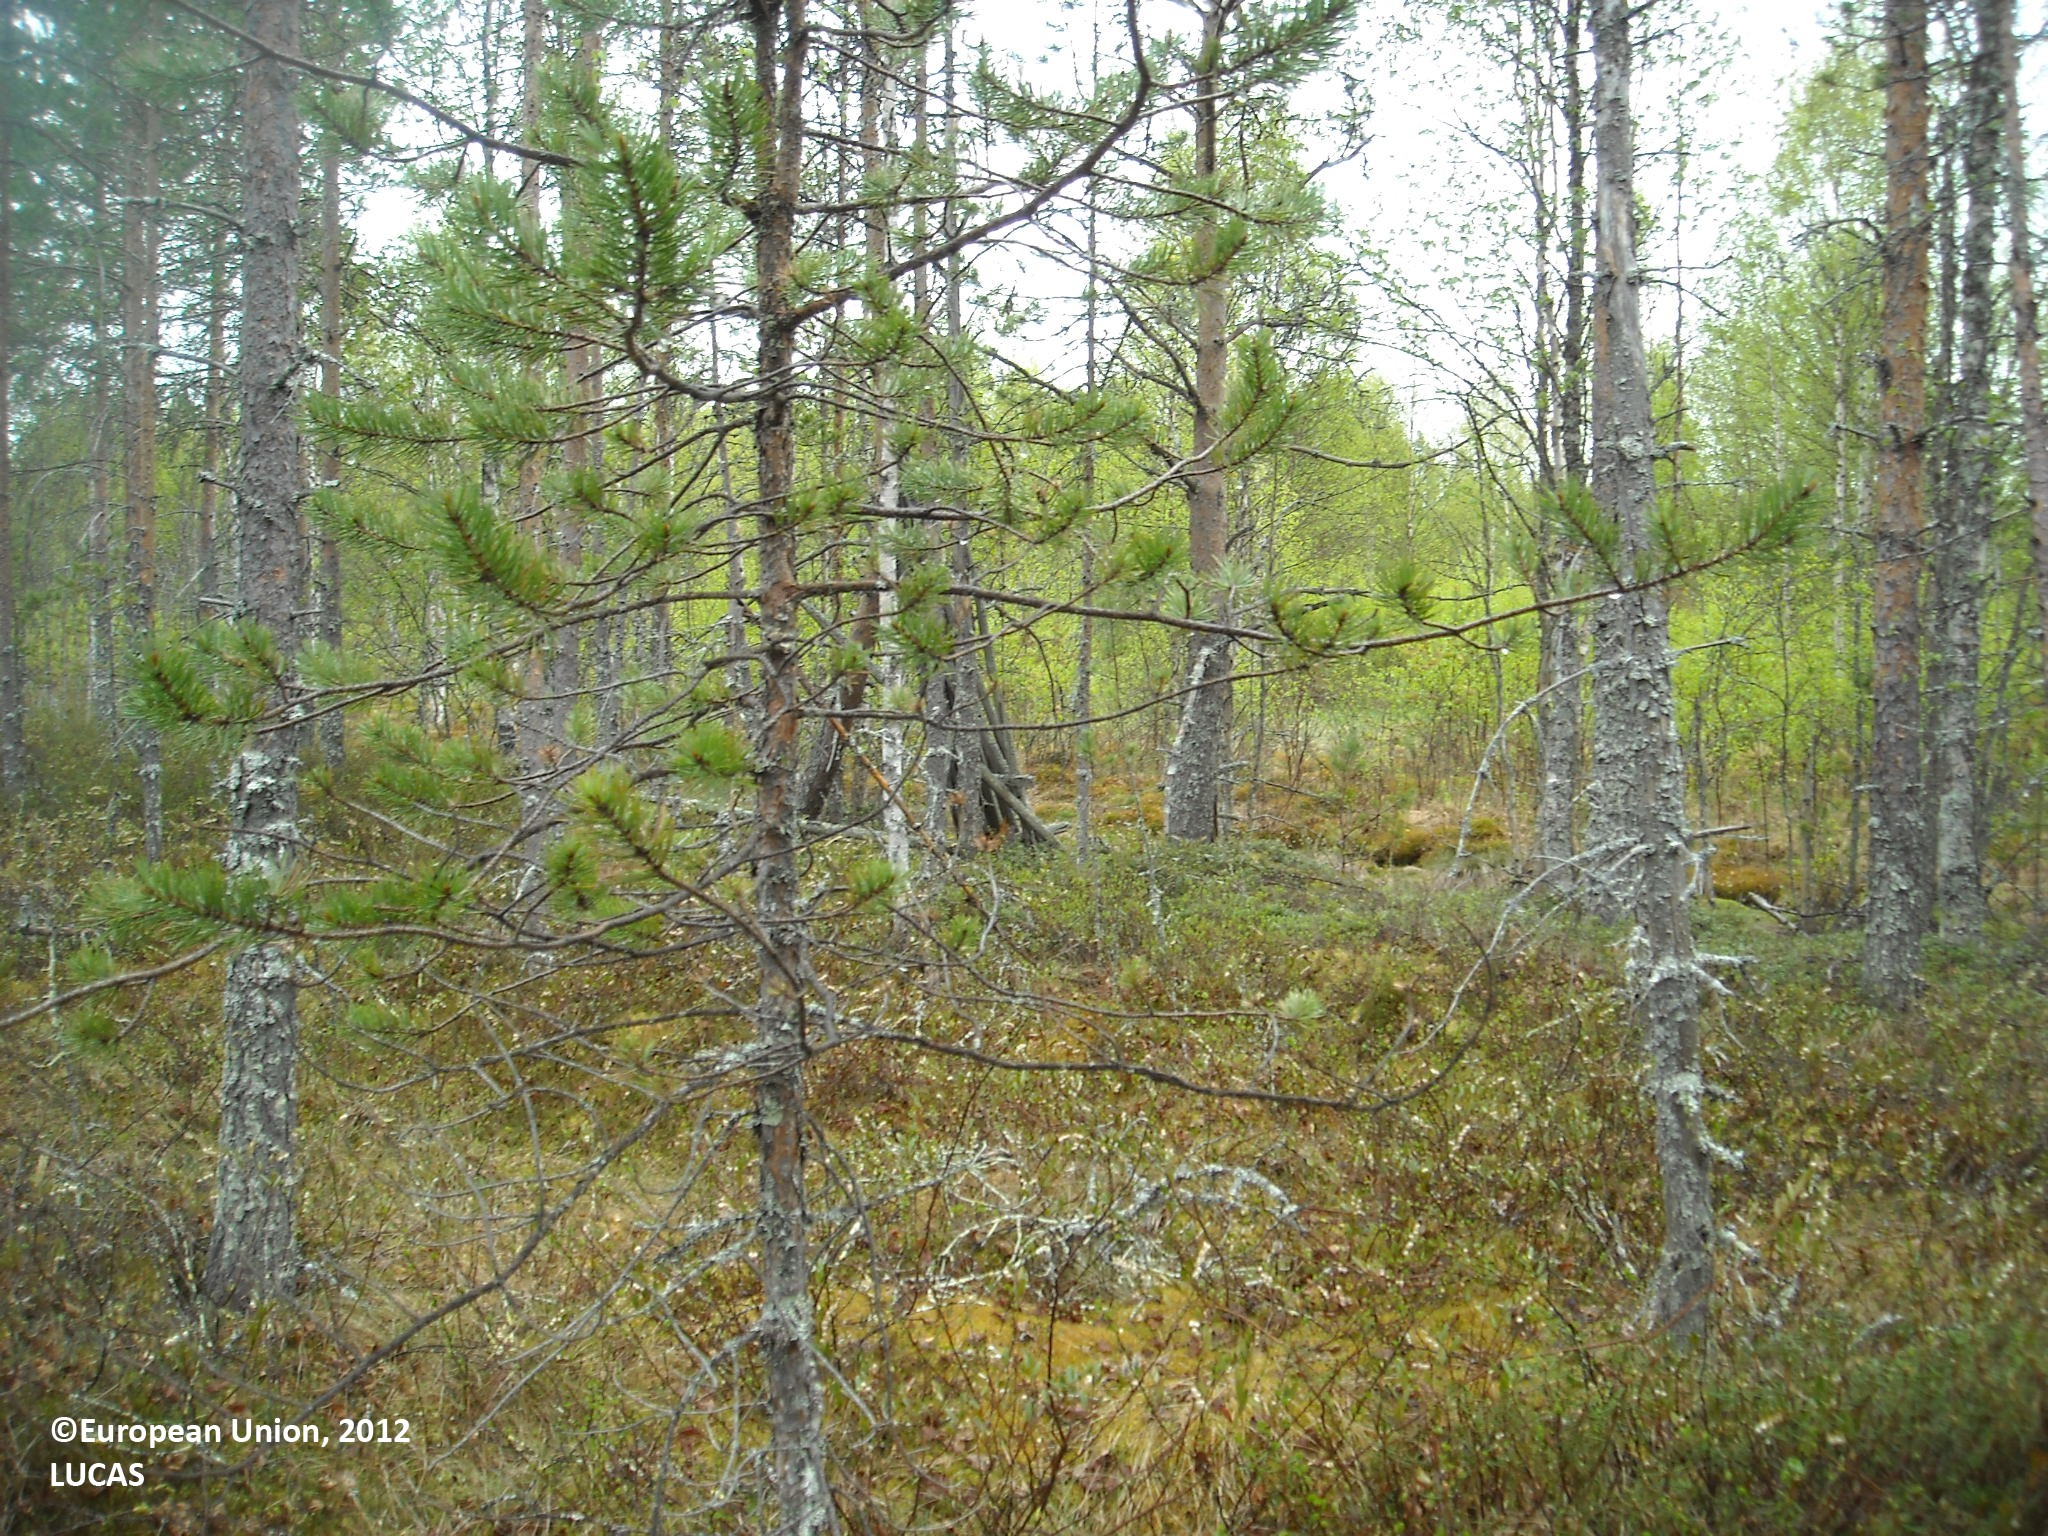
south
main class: Woodland
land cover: Pine dominated coniferous woodland
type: mire and swamp forests
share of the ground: > 75 %
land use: Forestry
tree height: > 5 m
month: June
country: FI
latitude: 64.5999
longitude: 27.2039
